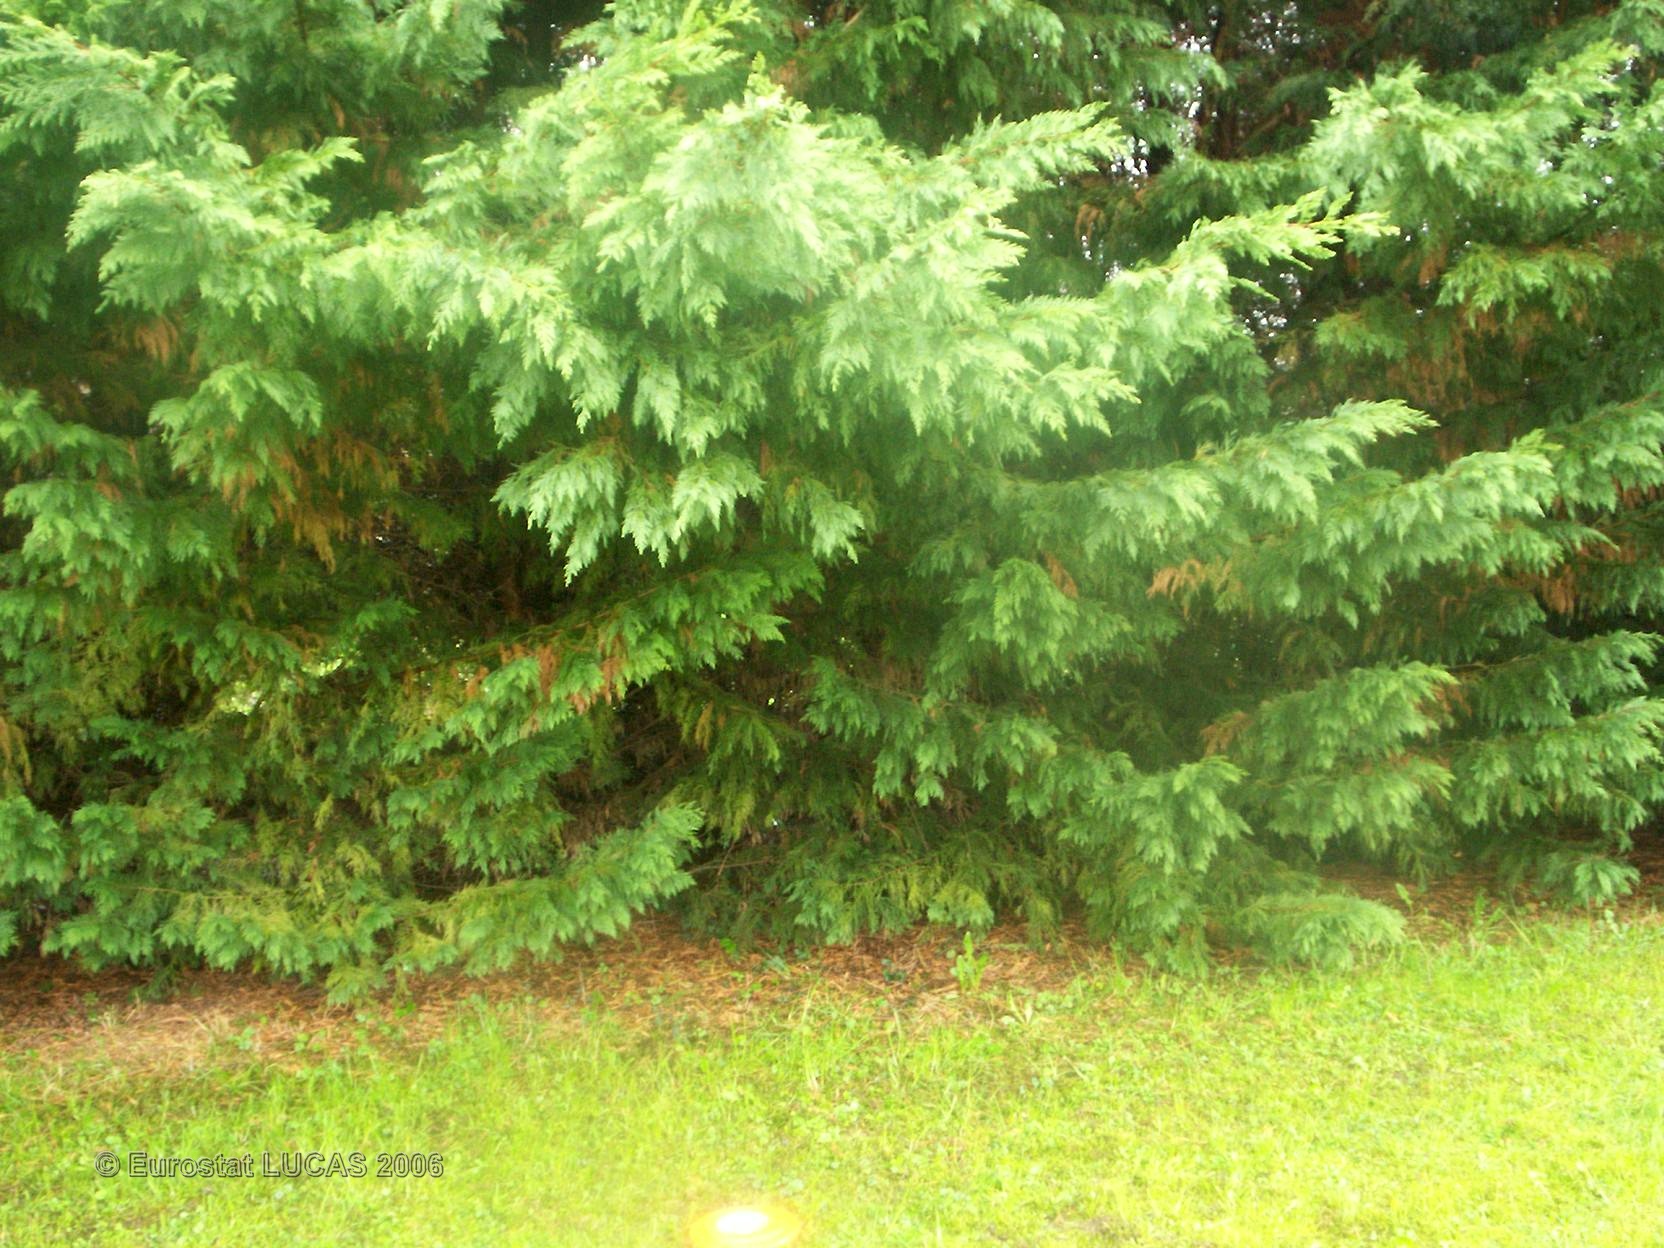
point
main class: Grassland
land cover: Grassland with sparse tree/shrub cover
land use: Residential
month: April
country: FR
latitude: 47.0311
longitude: 3.0876
